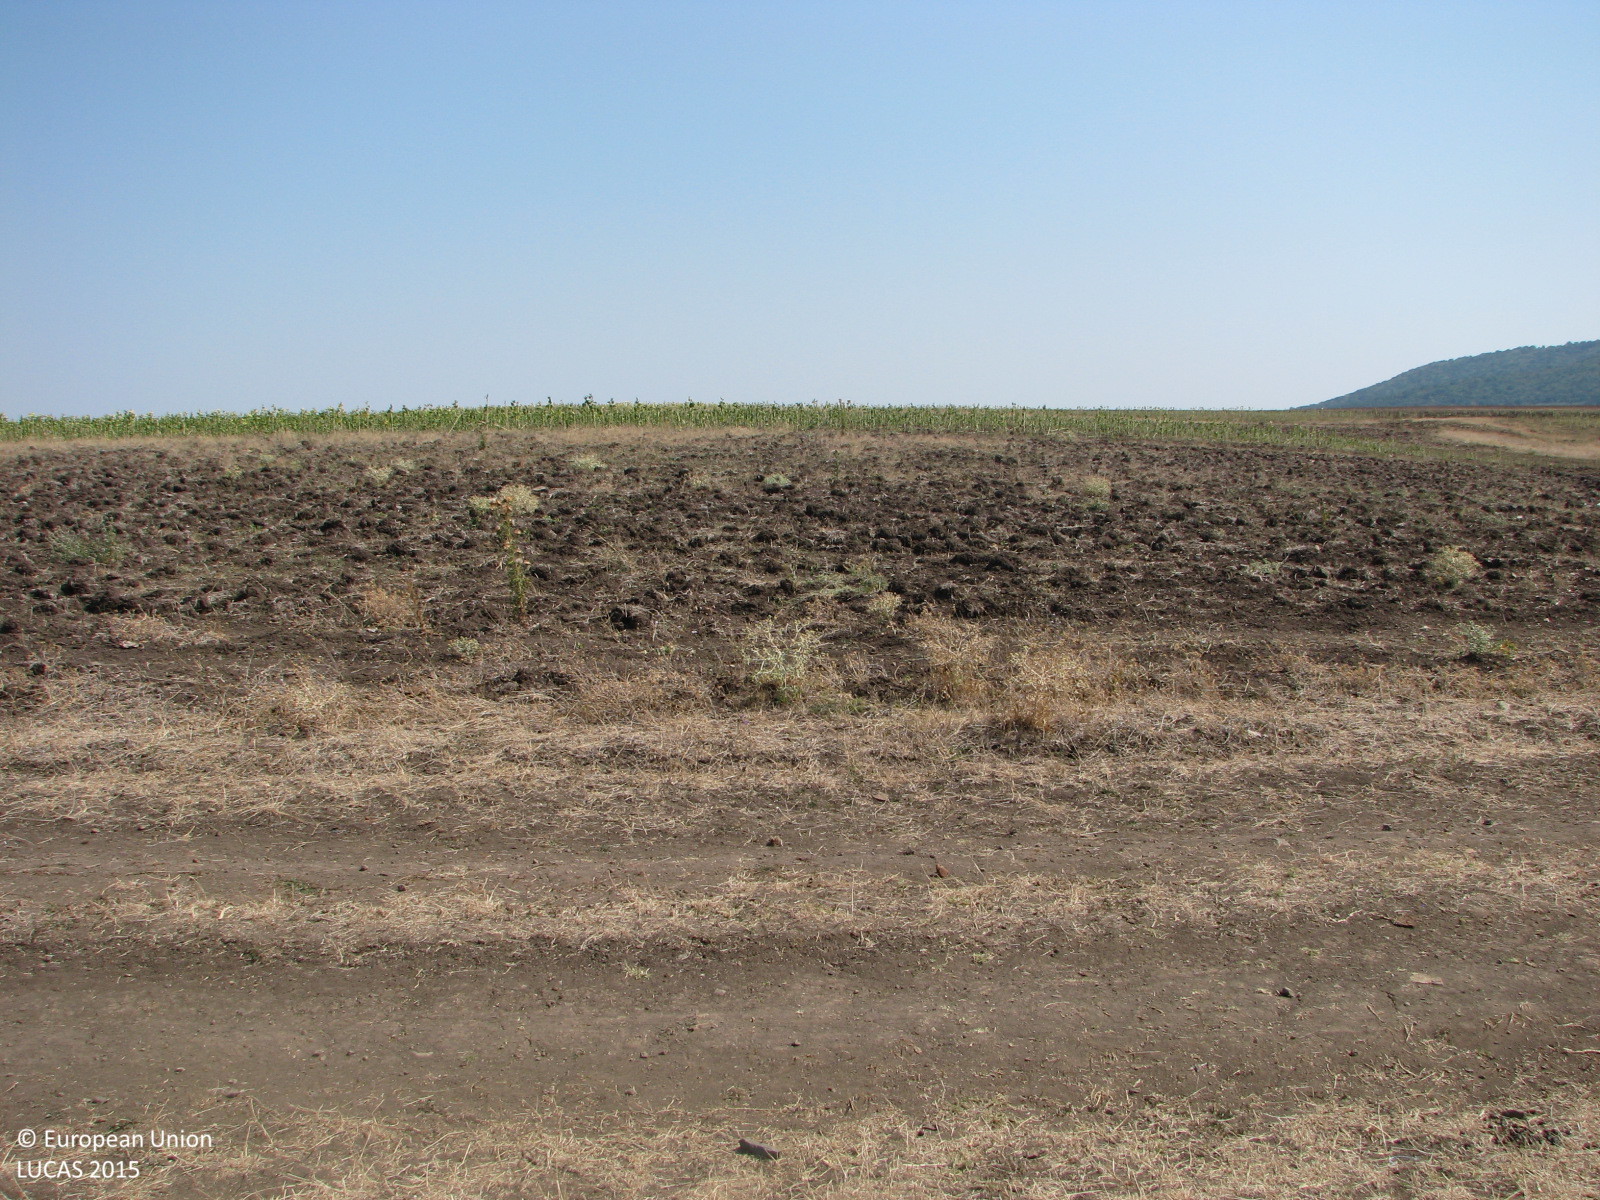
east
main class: Grassland
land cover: Grassland without tree/shrub cover
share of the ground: > 75 %
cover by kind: herbaceous plants 90 %, unconsolidated bare surface 10 %
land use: Agriculture (excluding fallow land and kitchen gardens)
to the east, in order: Grassland without tree/shrub cover; Tracks; Other bare soil; Sunflower; Other bare soil; Sunflower
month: September
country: BG
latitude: 42.3805
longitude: 26.7979
